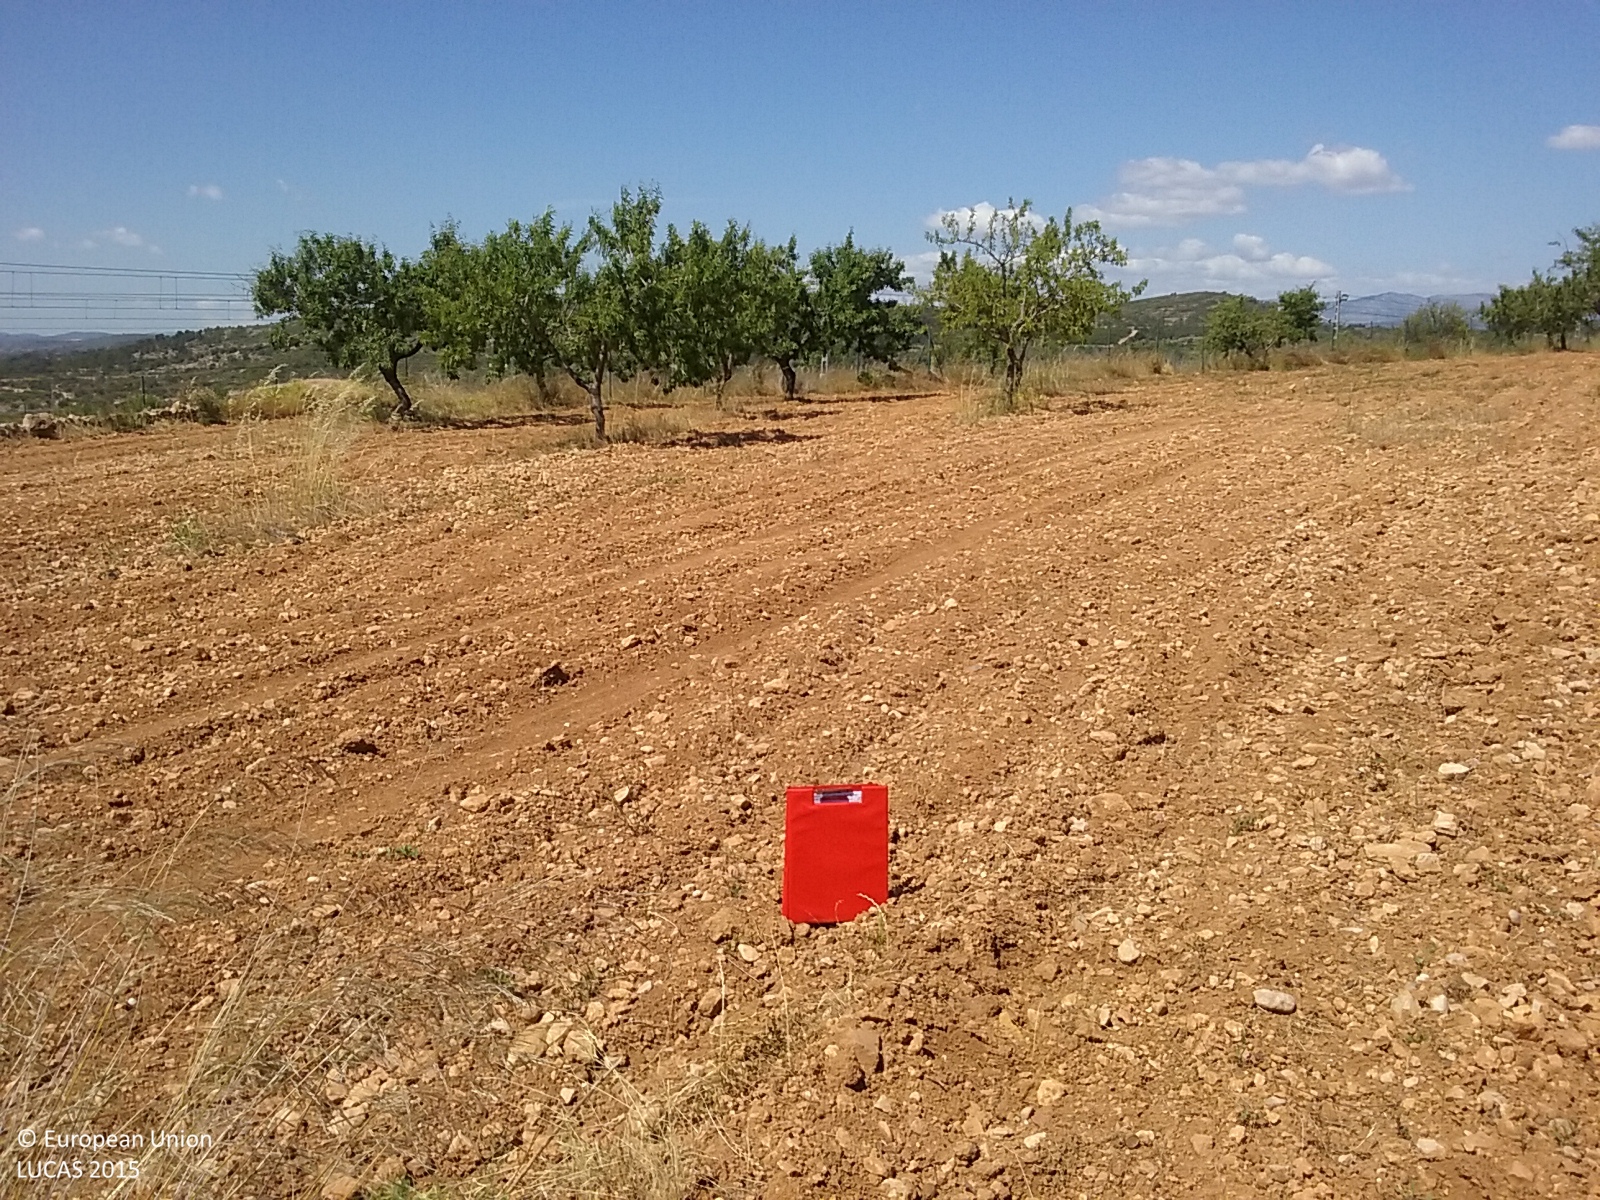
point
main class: Cropland
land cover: Nuts trees
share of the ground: < 10 %
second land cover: Other bare soil
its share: > 75 %
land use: Agriculture (excluding fallow land and kitchen gardens)
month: May
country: ES
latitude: 40.2721
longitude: 0.2484
